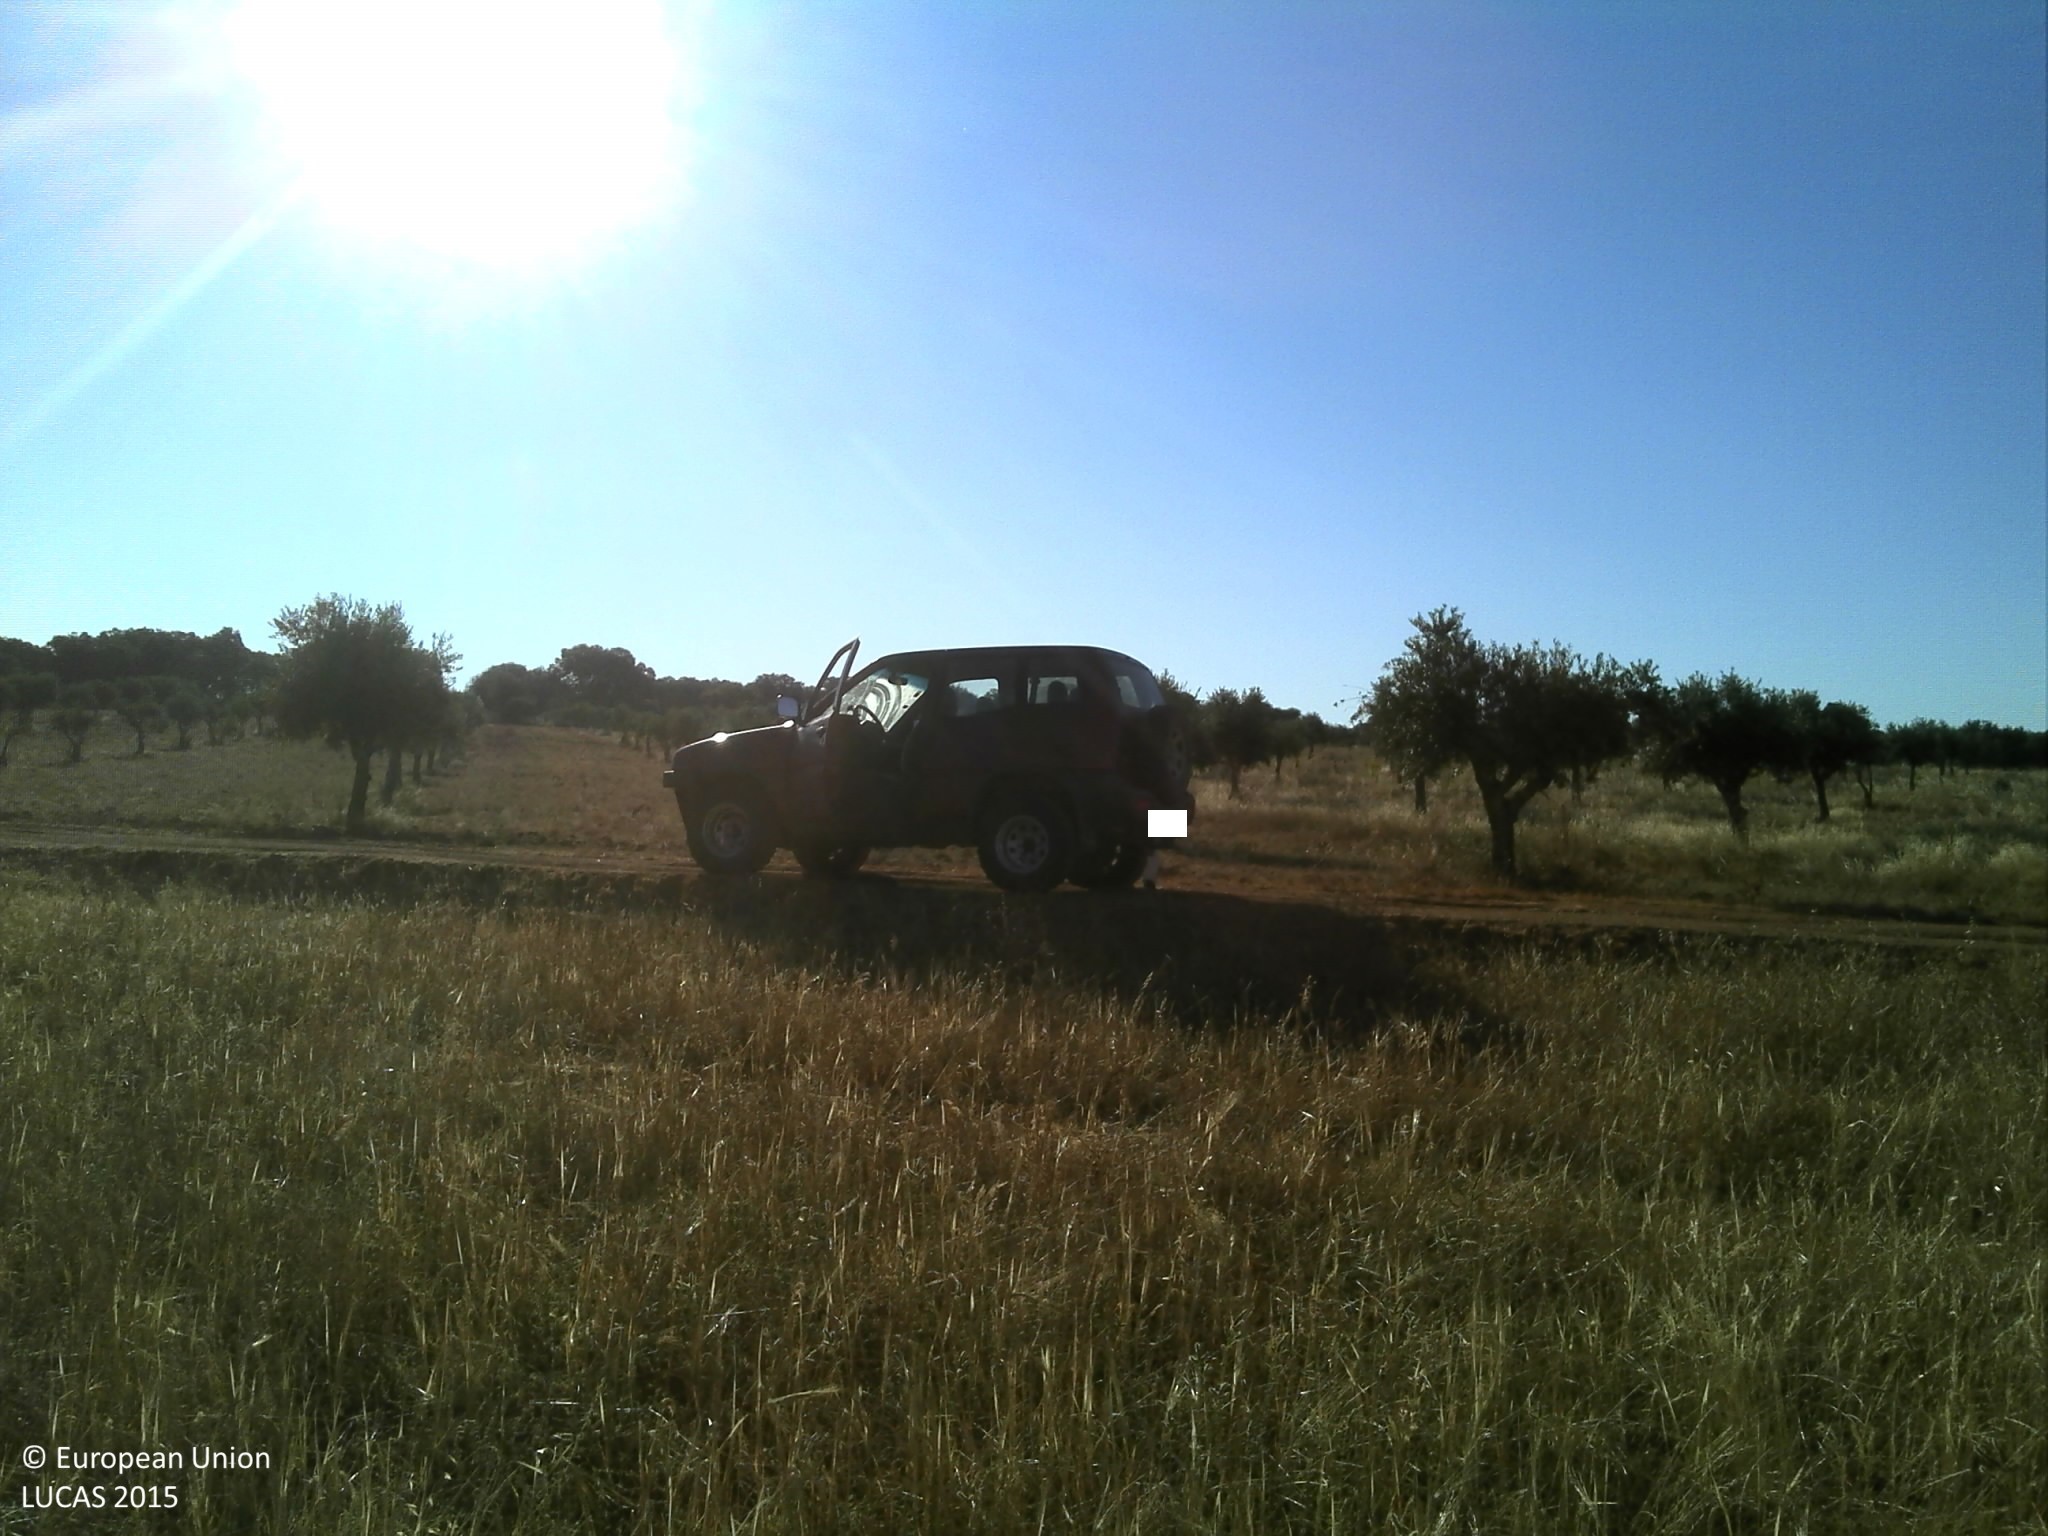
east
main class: Cropland
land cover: Triticale
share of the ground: 10 - 25 %
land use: Agriculture (excluding fallow land and kitchen gardens)
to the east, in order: Triticale; Grass margins; Tracks; Grass margins; Olive groves; Shruby margins; Fences; Shrubland with sparse tree cover; Tracks; Other bare soil; Broadleaved woodland
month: July
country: PT
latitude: 38.9281
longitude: -7.5596
